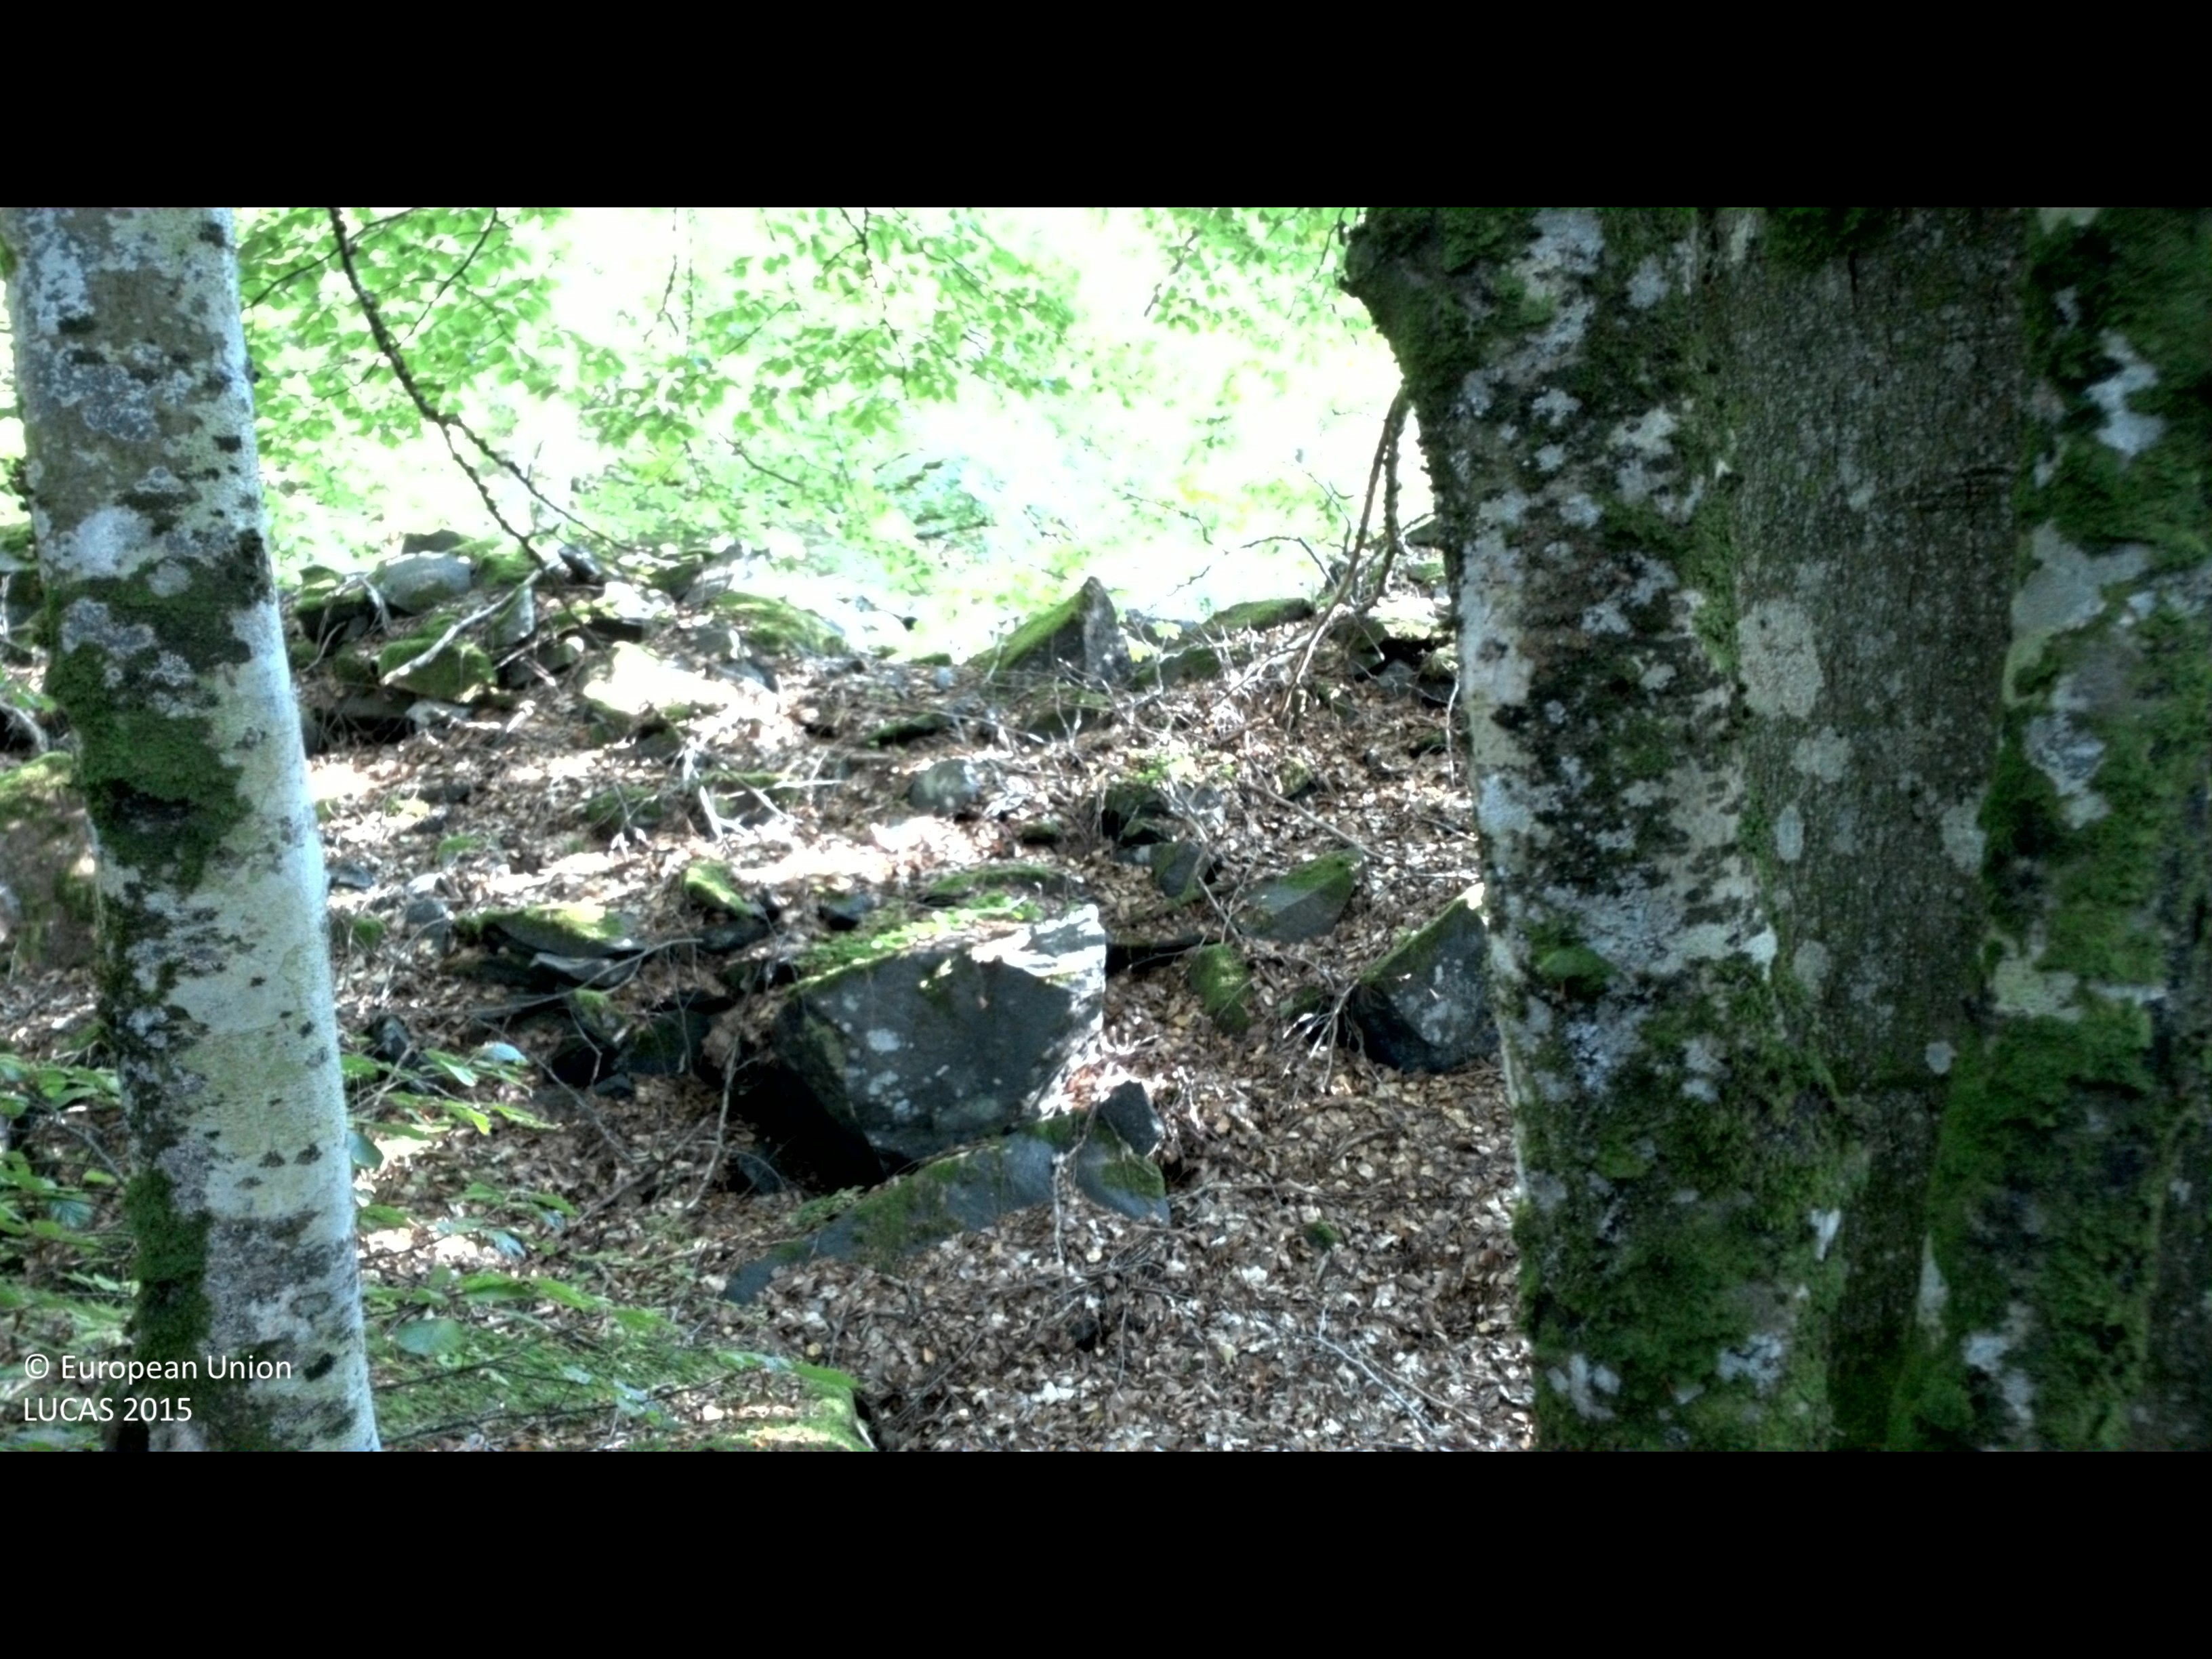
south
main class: Woodland
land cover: Broadleaved woodland
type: beech forest
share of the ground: > 75 %
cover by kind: broadleaved forest trees 80 %
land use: Forestry
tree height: > 5 m
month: September
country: SE
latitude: 56.1720
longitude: 14.2338
